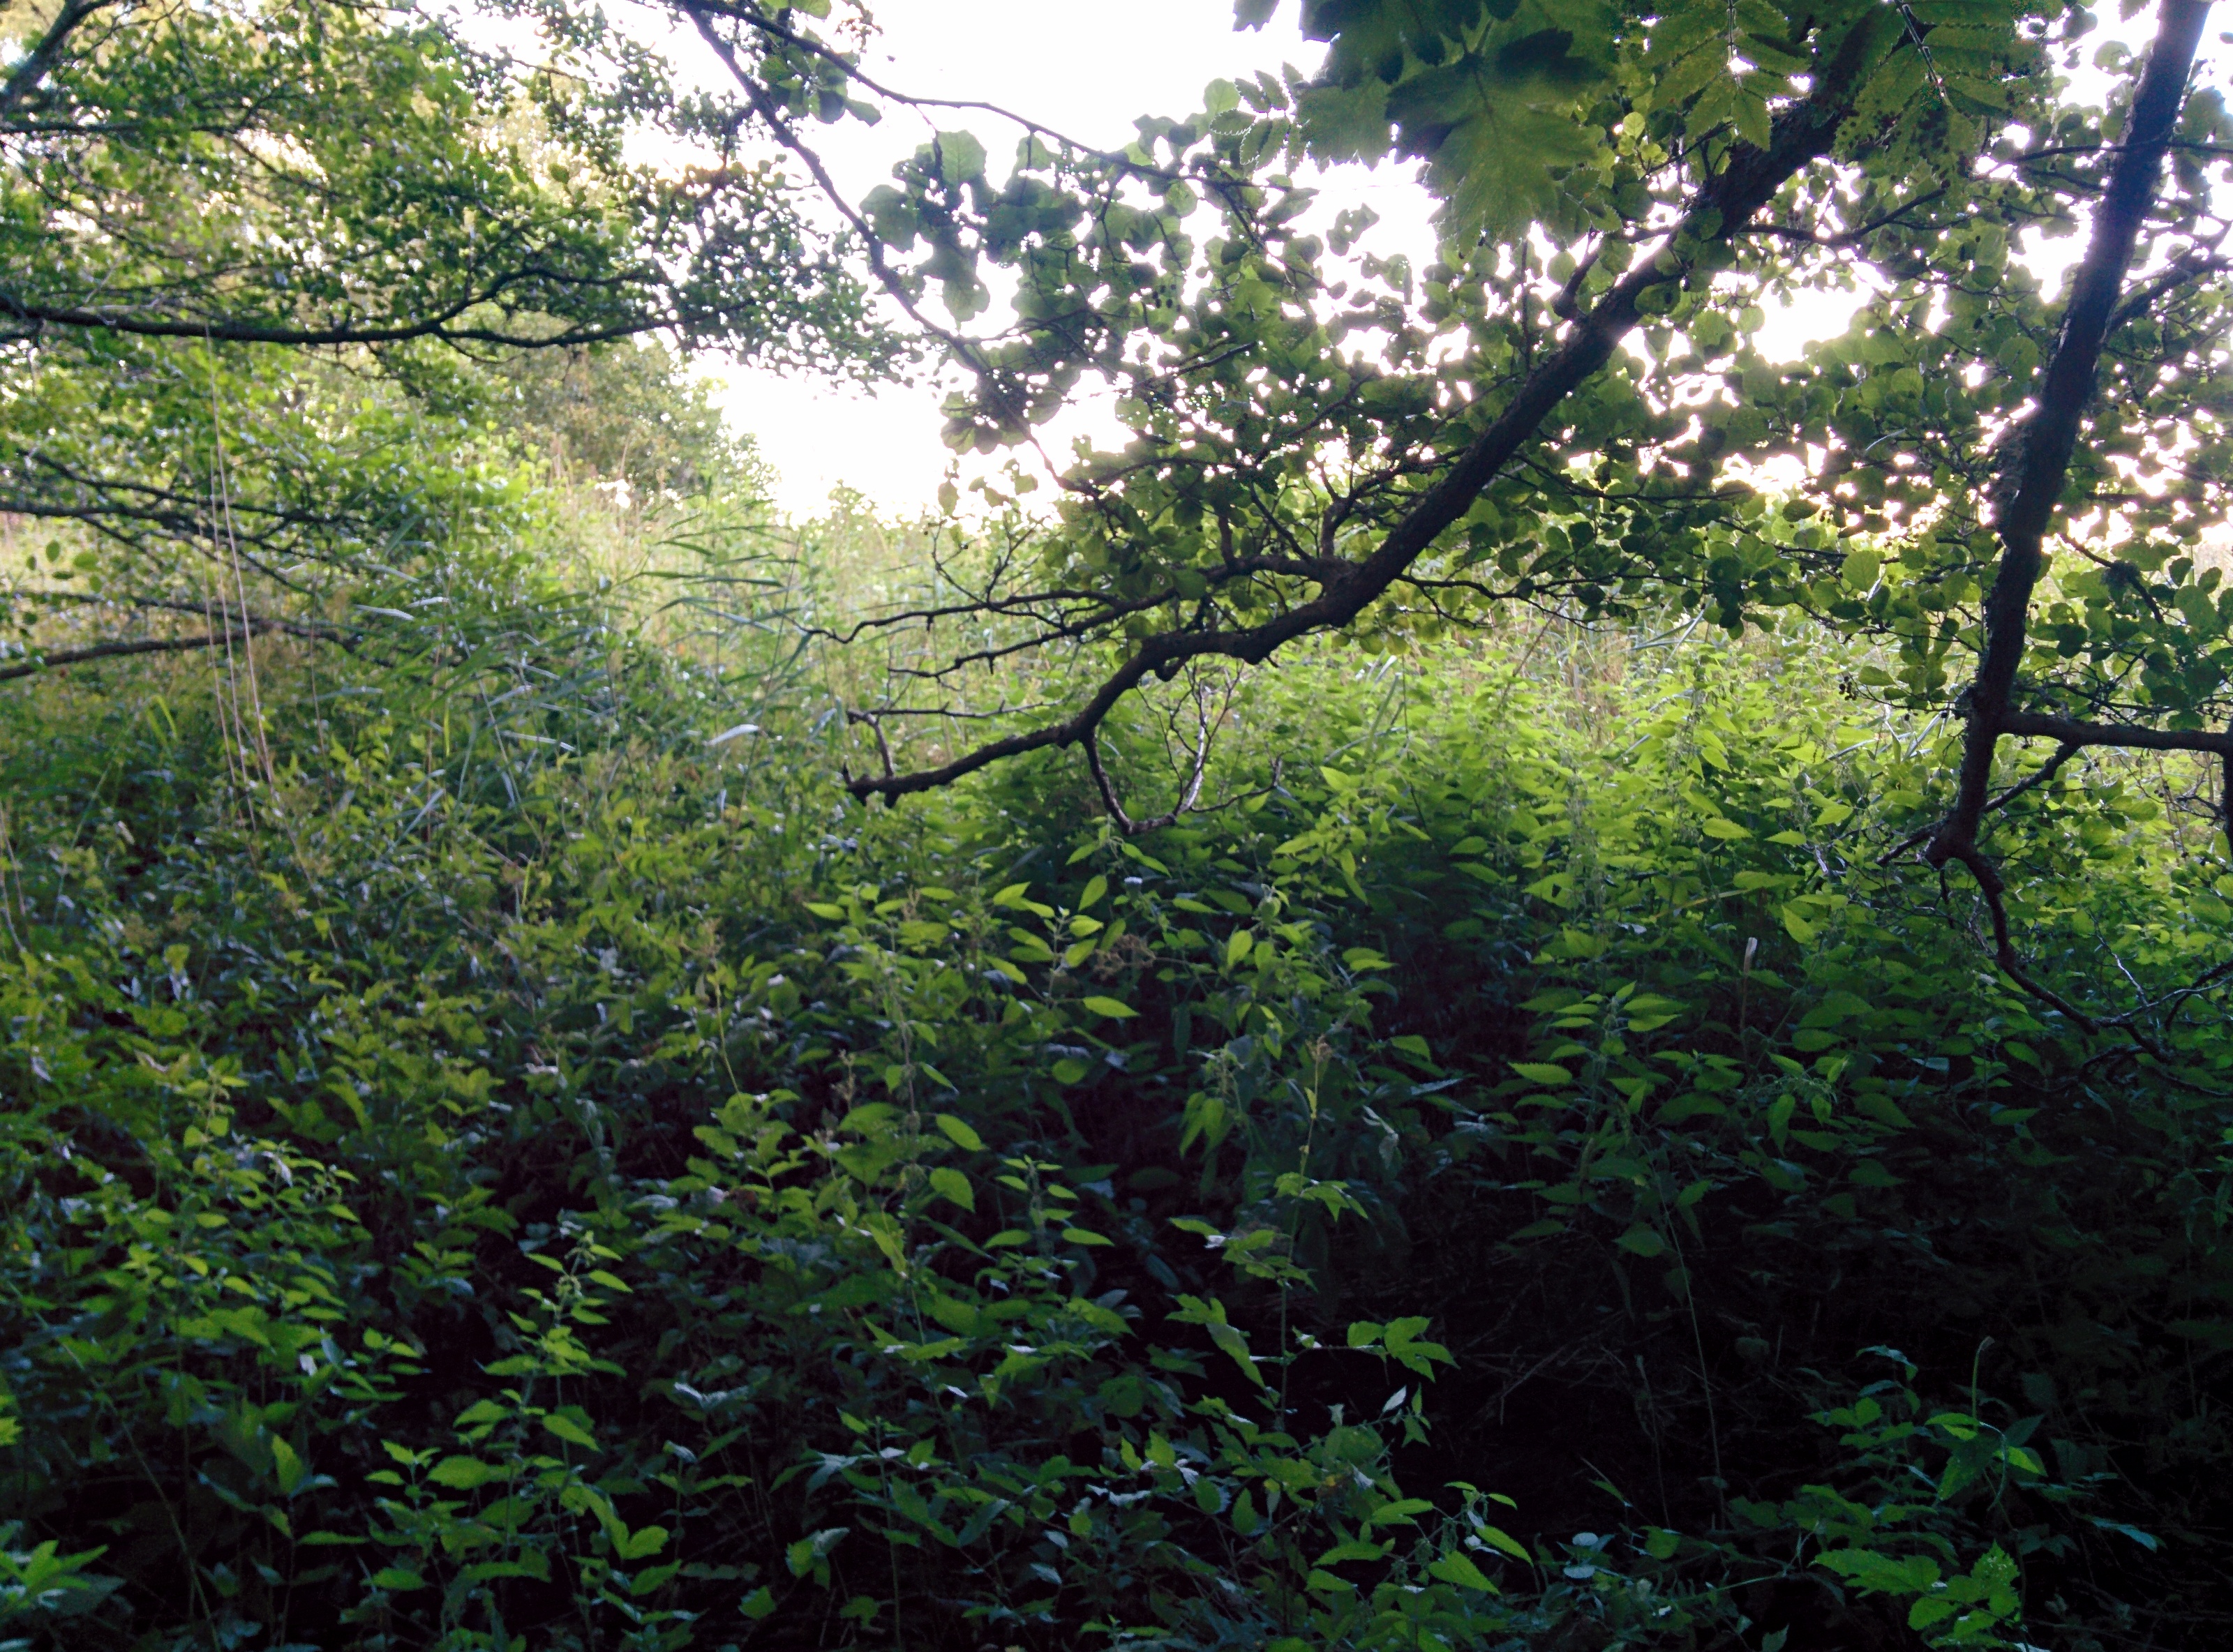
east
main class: Woodland
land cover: Broadleaved woodland
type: hemiboreal forest and nemoral coniferous forest and mixed broadleaved-coniferous forest
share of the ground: > 75 %
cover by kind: broadleaved forest trees 75 %, coniferous forest trees 10 %, unconsolidated bare surface 10 %, herbaceous plants 5 %
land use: Forestry
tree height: > 5 m
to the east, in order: Broadleaved woodland
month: August
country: SE
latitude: 58.9391
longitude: 17.6965
